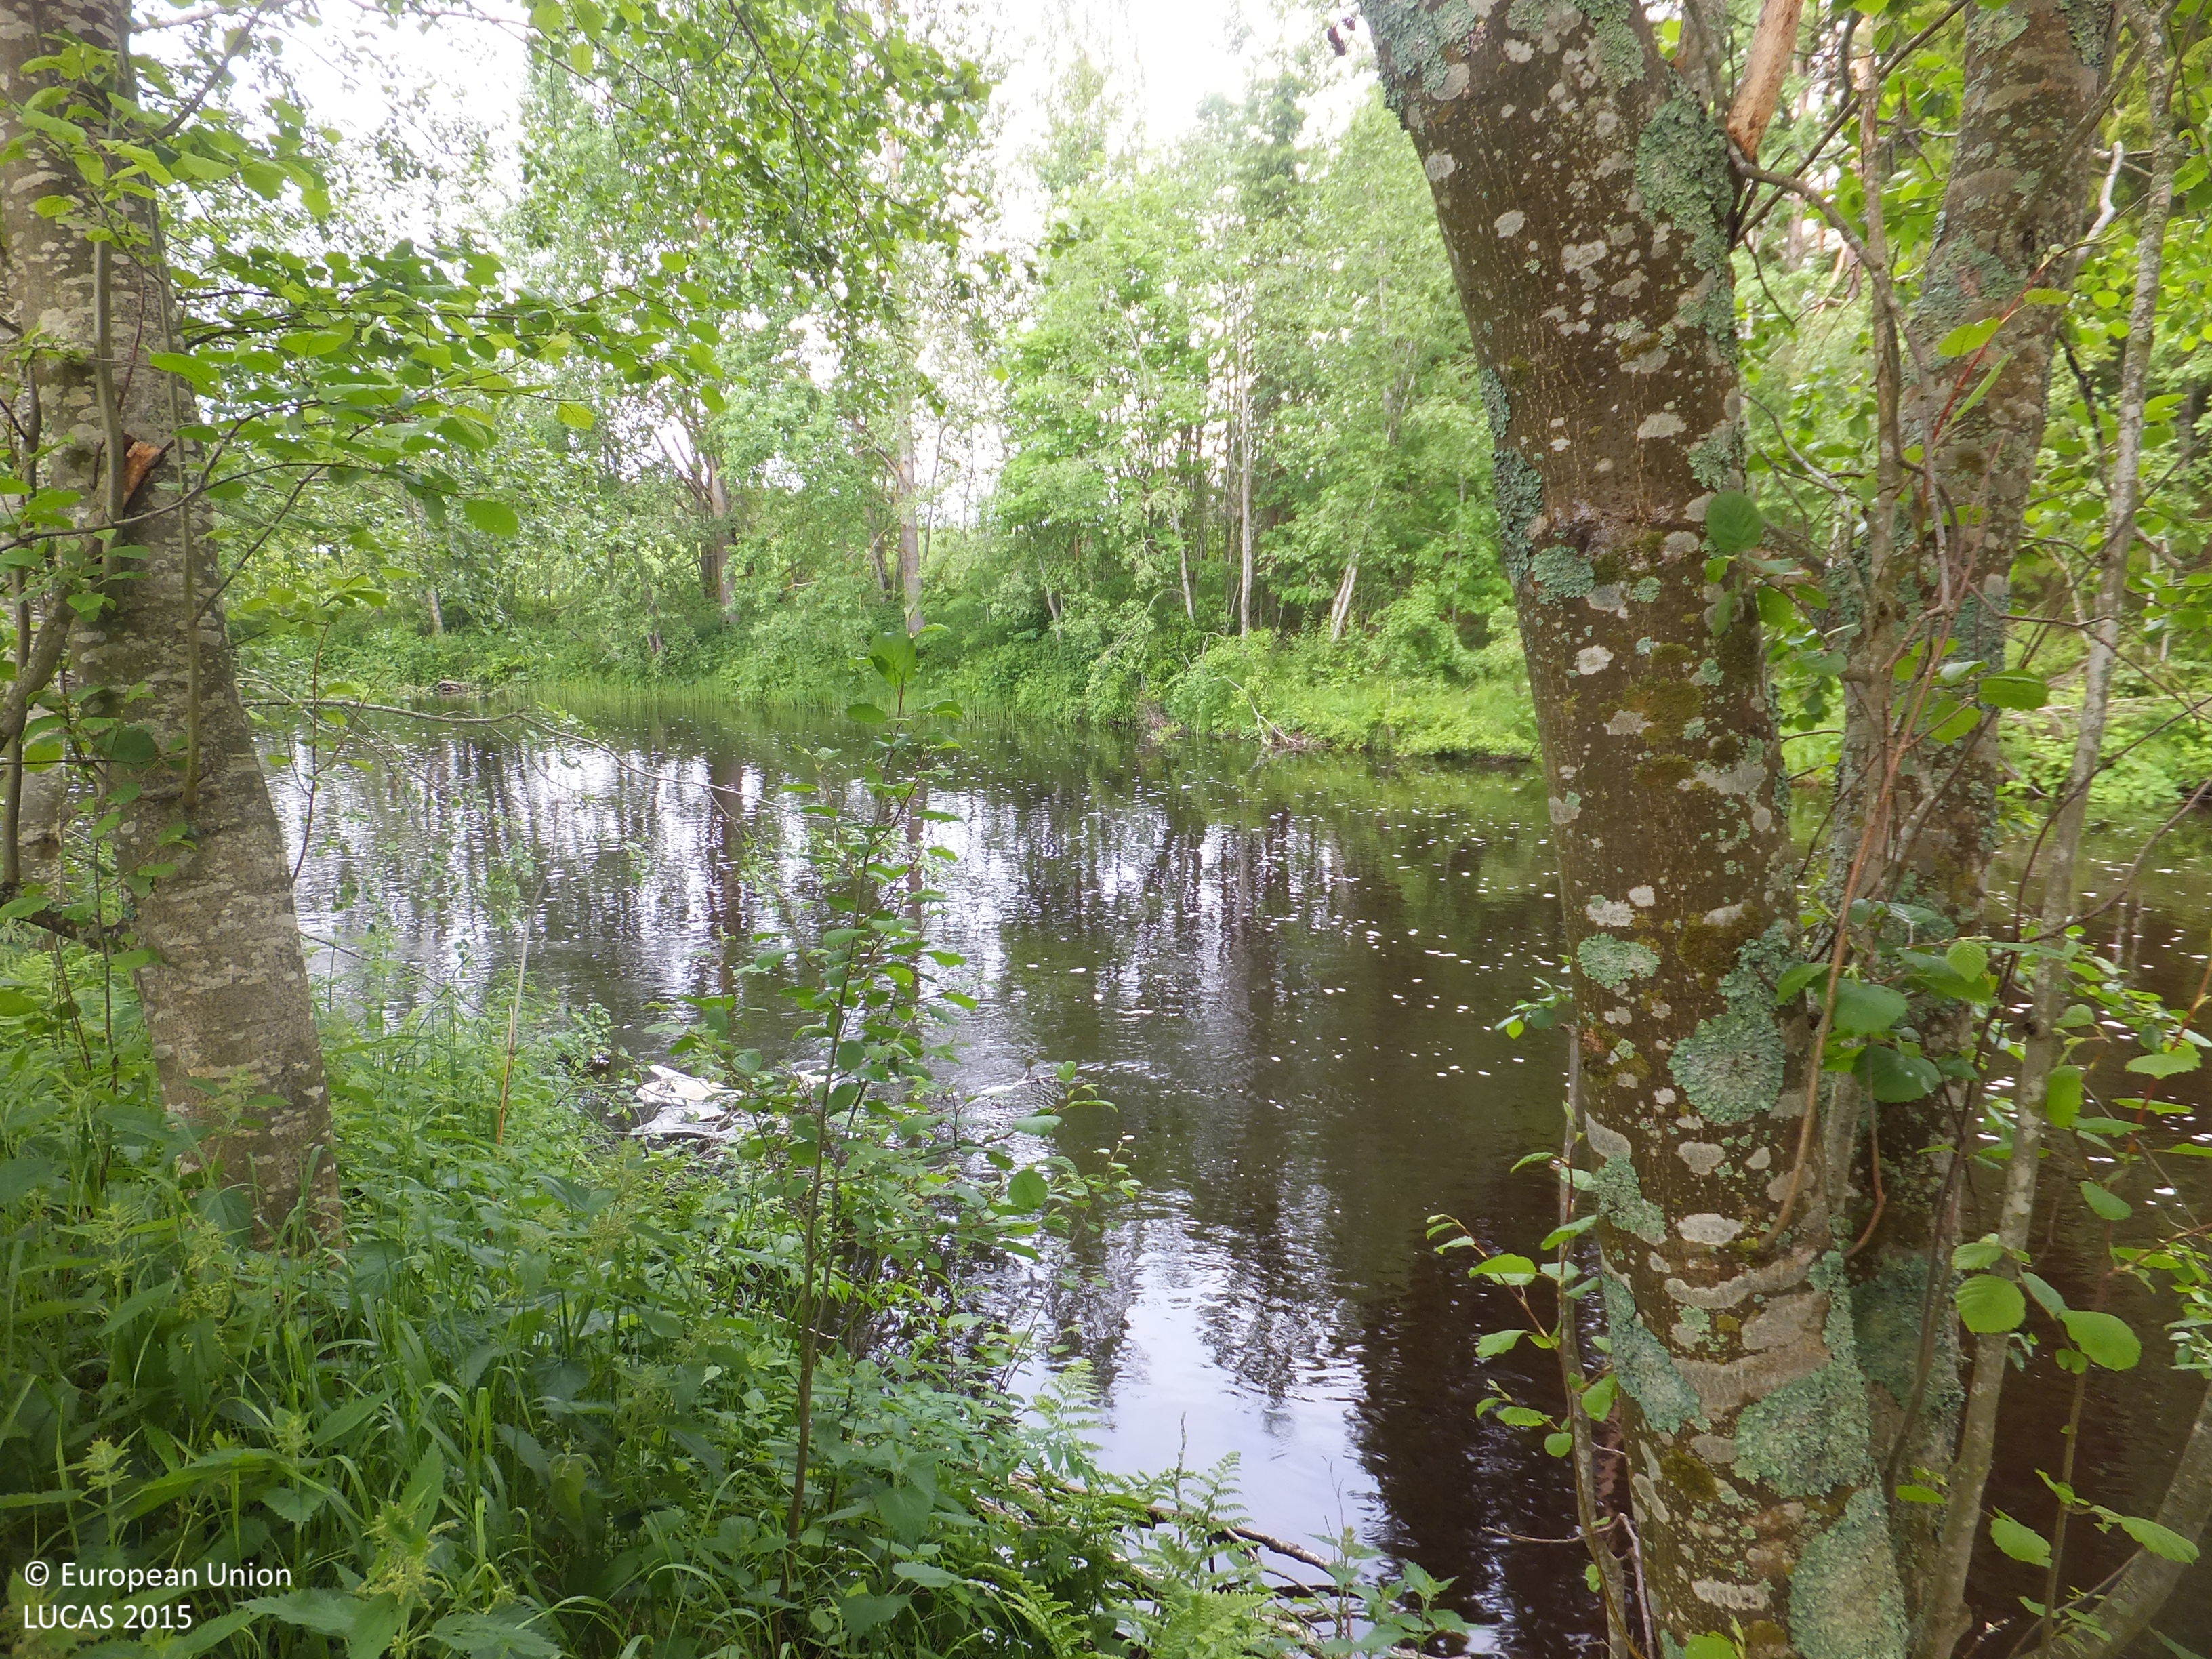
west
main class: Woodland
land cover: Broadleaved woodland
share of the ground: 50 - 75 %
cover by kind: broadleaved forest trees 60 %, herbaceous plants 40 %
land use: Semi-natural and natural areas not in use
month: June
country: FI
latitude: 63.3293
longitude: 24.0309
